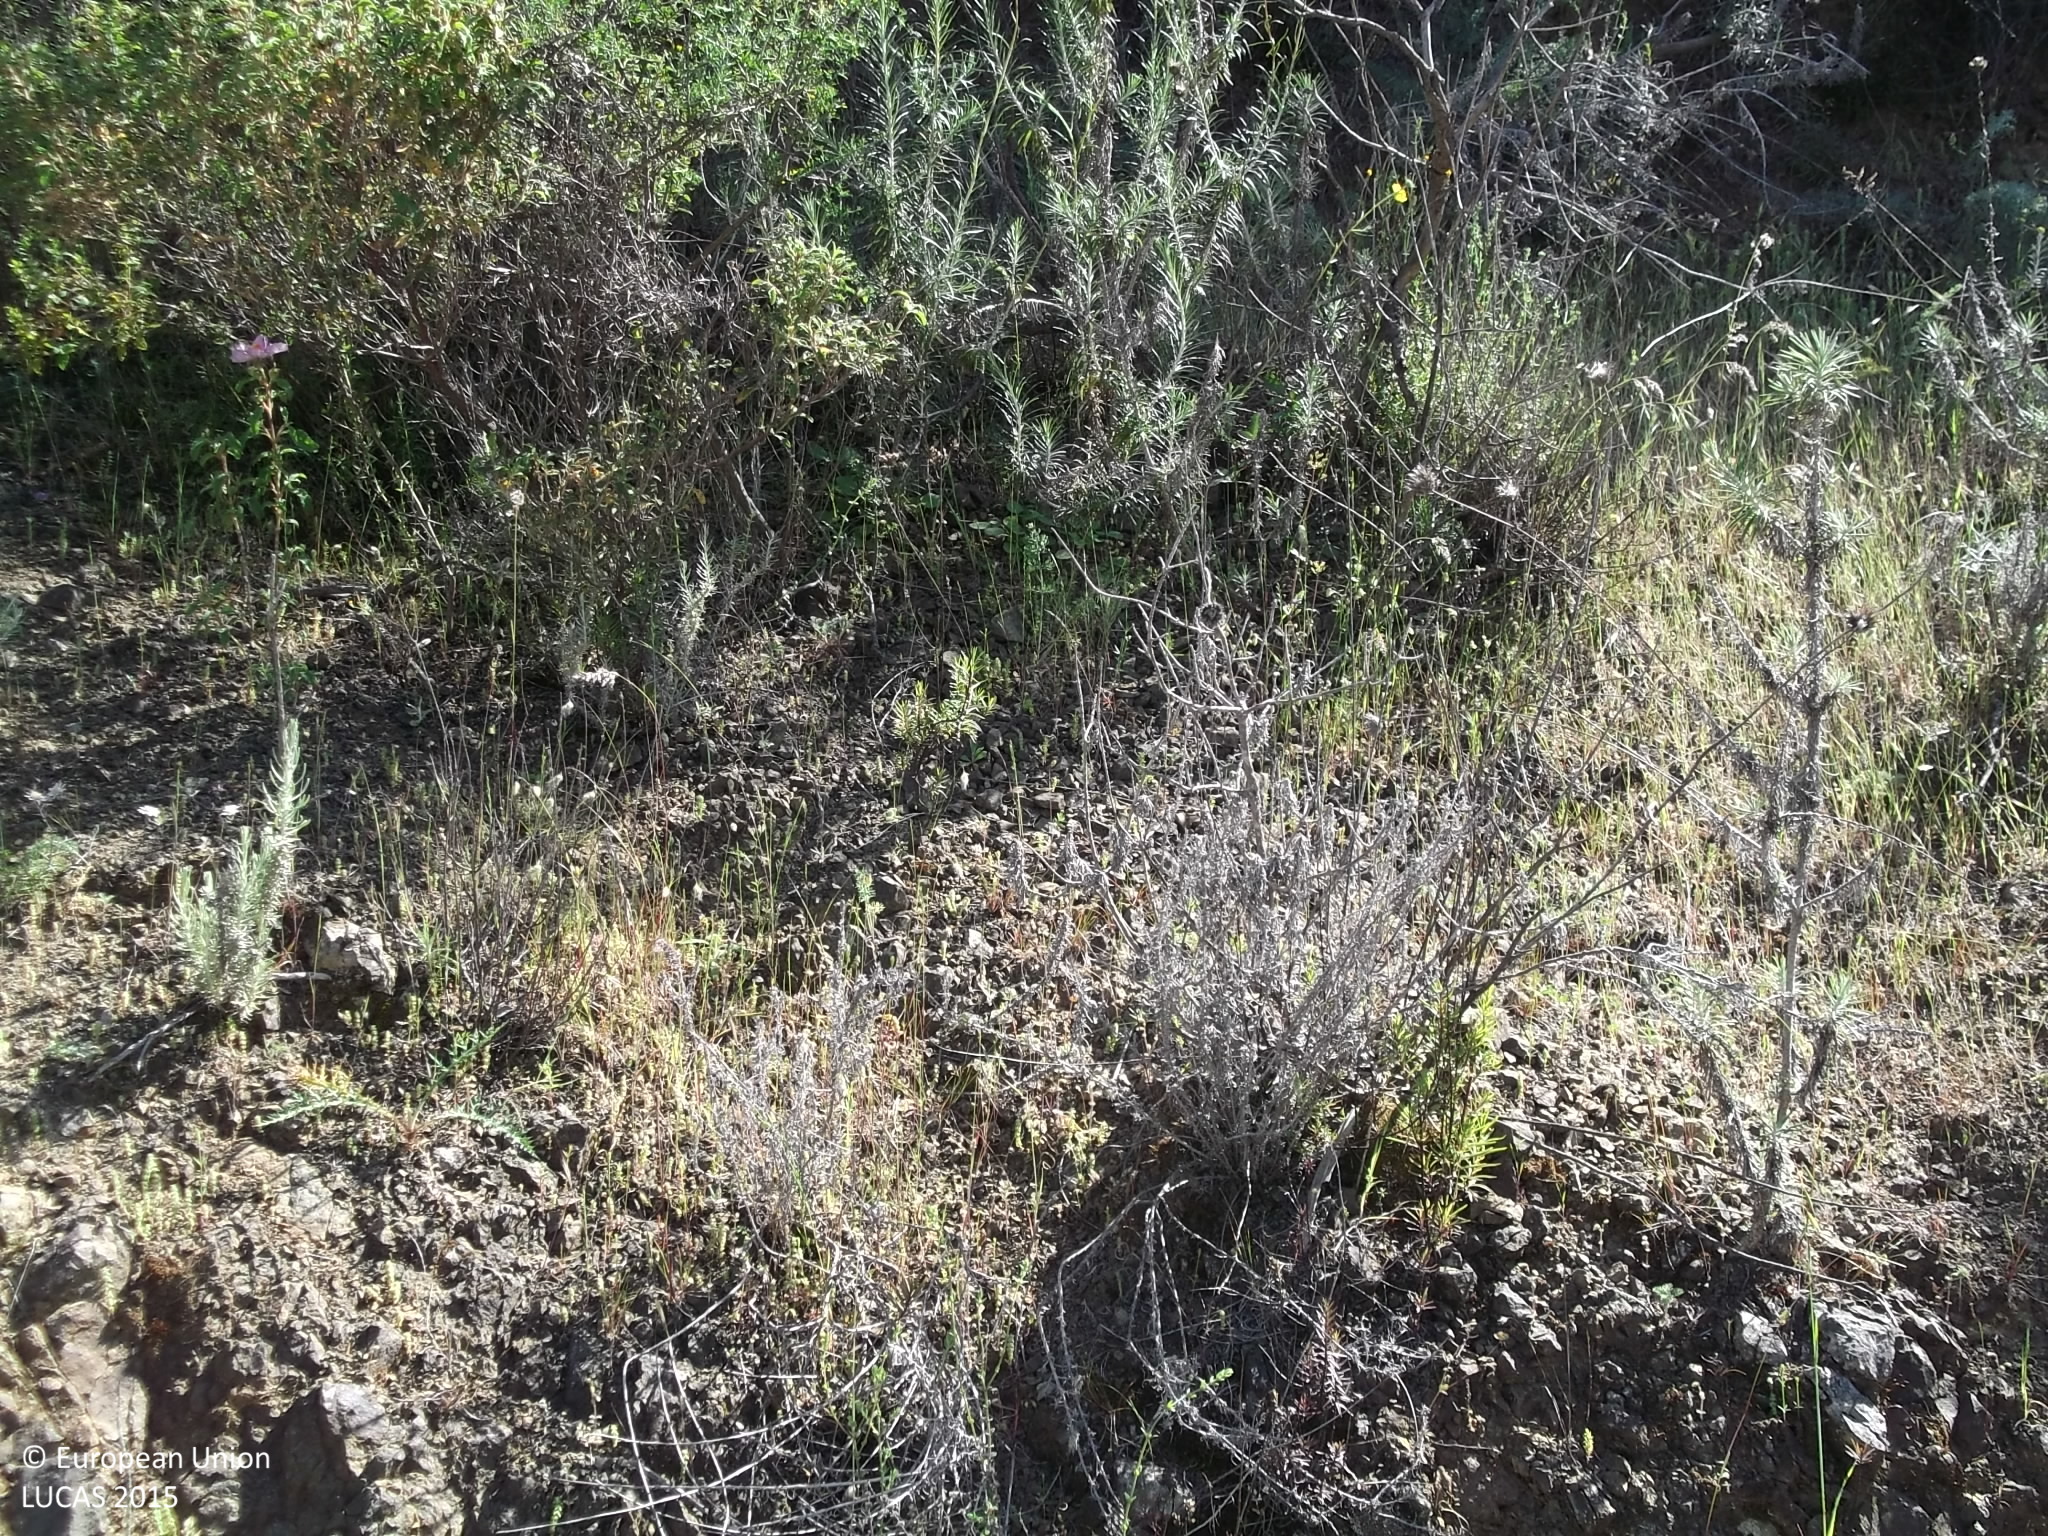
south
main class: Shrubland
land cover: Shrubland with sparse tree cover
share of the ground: > 75 %
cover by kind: shrubs 85 %, unconsolidated bare surface 10 %, coniferous forest trees 5 %
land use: Semi-natural and natural areas not in use
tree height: > 5 m
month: April
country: CY
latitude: 34.8421
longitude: 33.1050
